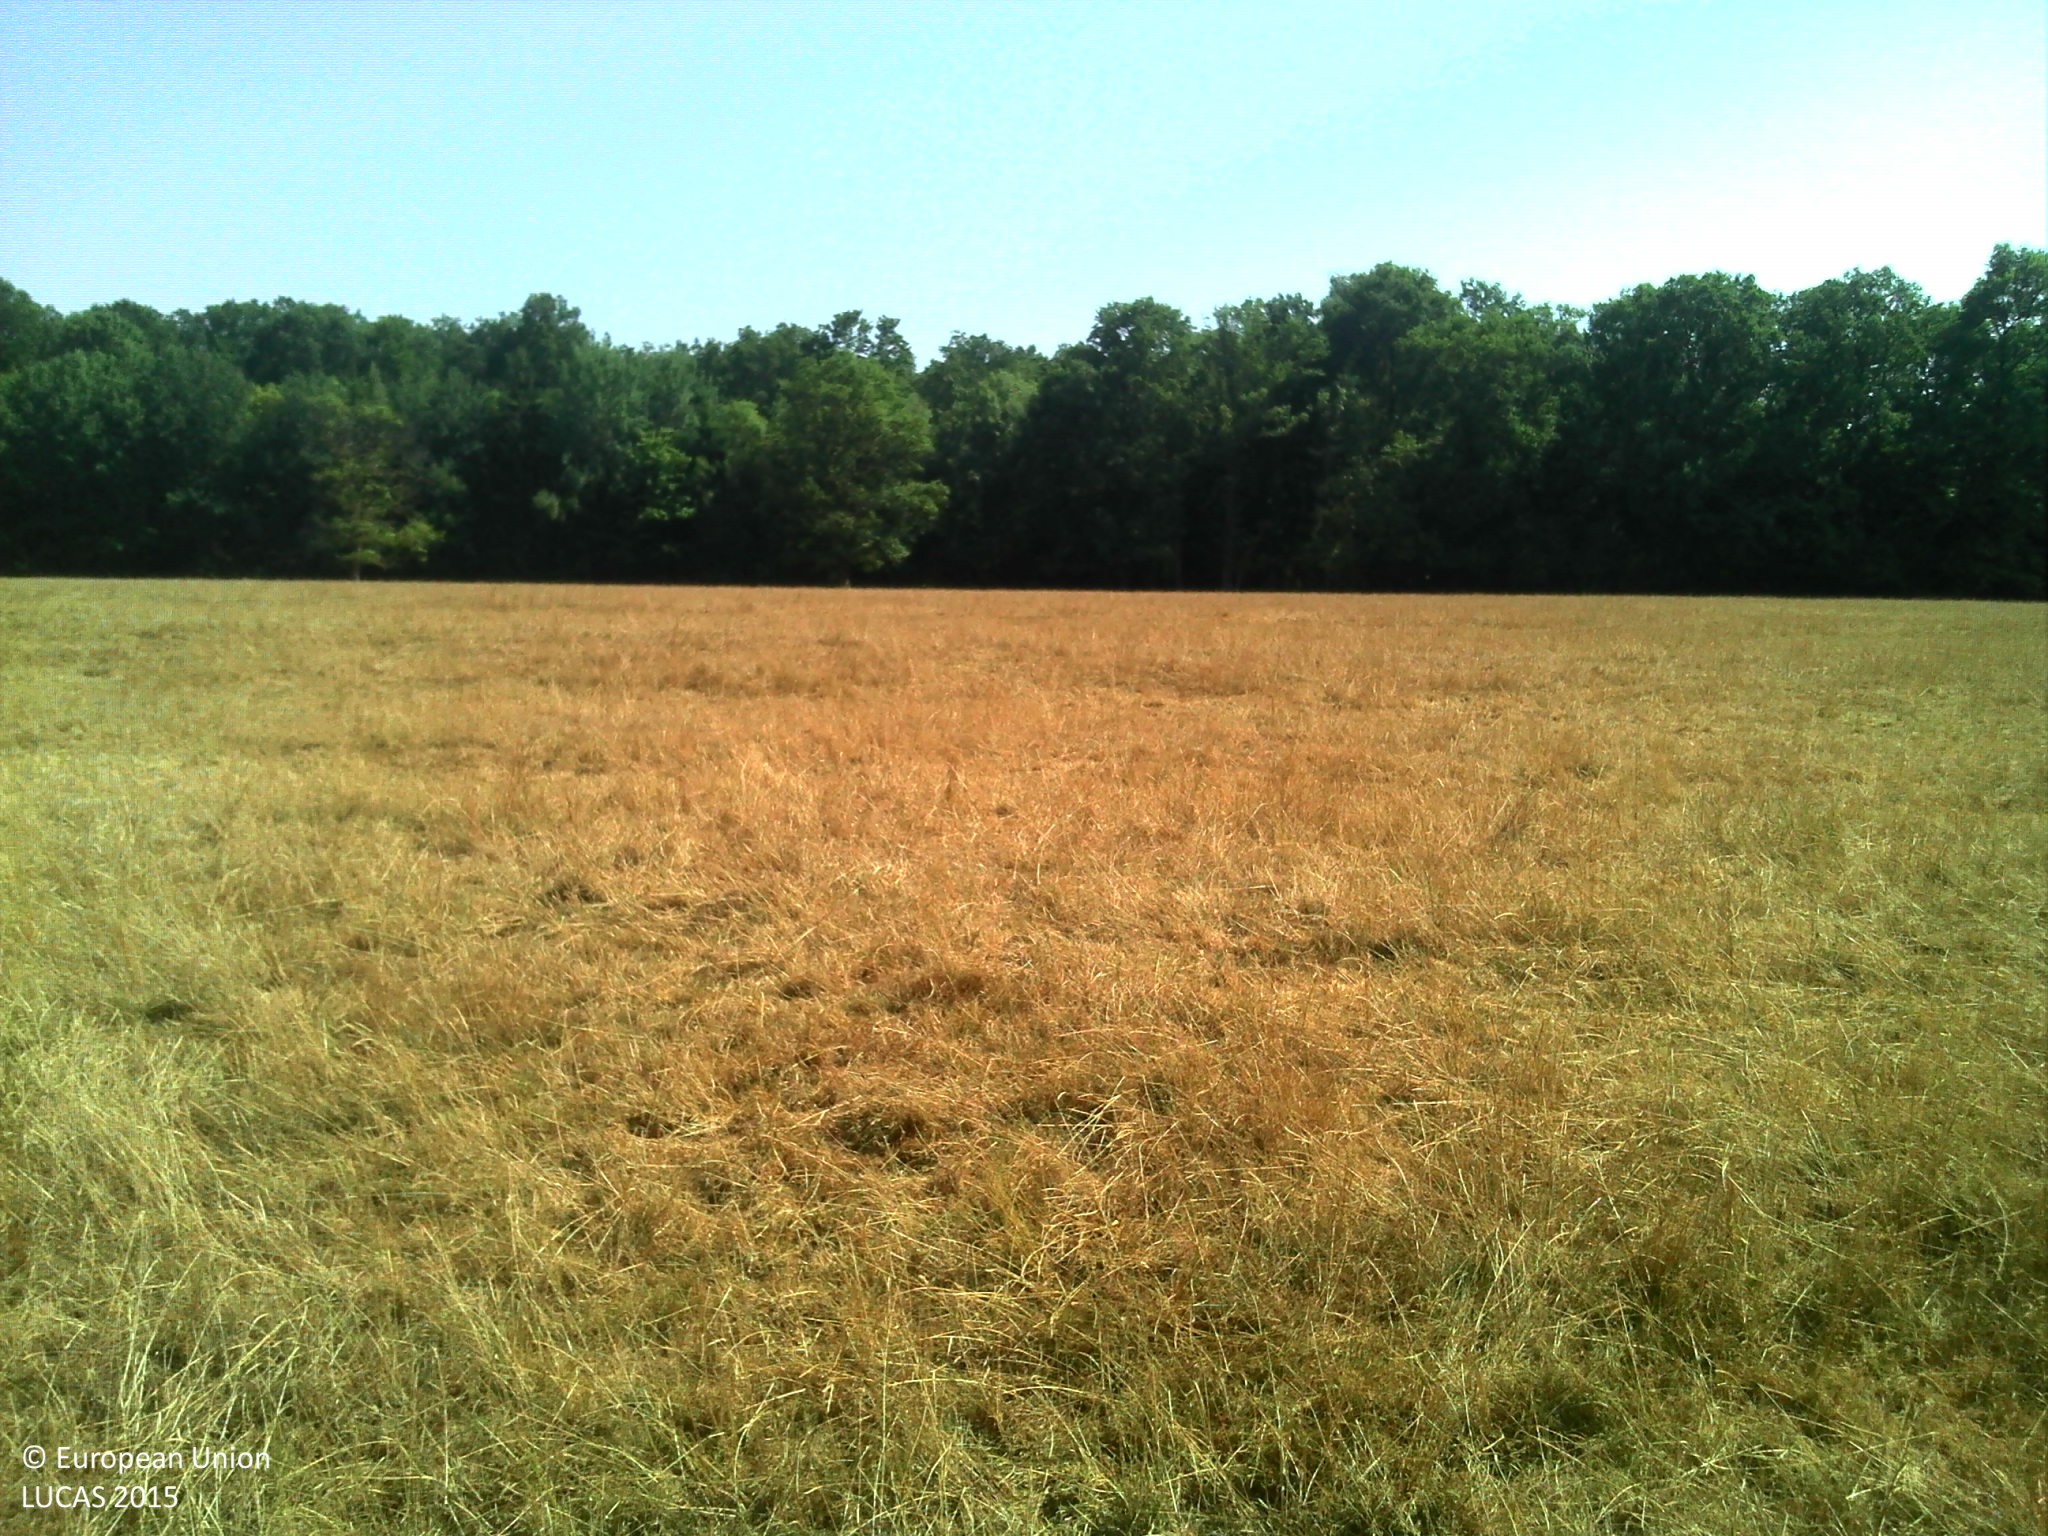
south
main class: Grassland
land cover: Grassland without tree/shrub cover
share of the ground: > 75 %
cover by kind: herbaceous plants 100 %
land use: Agriculture (excluding fallow land and kitchen gardens)
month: July
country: FR
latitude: 49.0525
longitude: 5.1132
